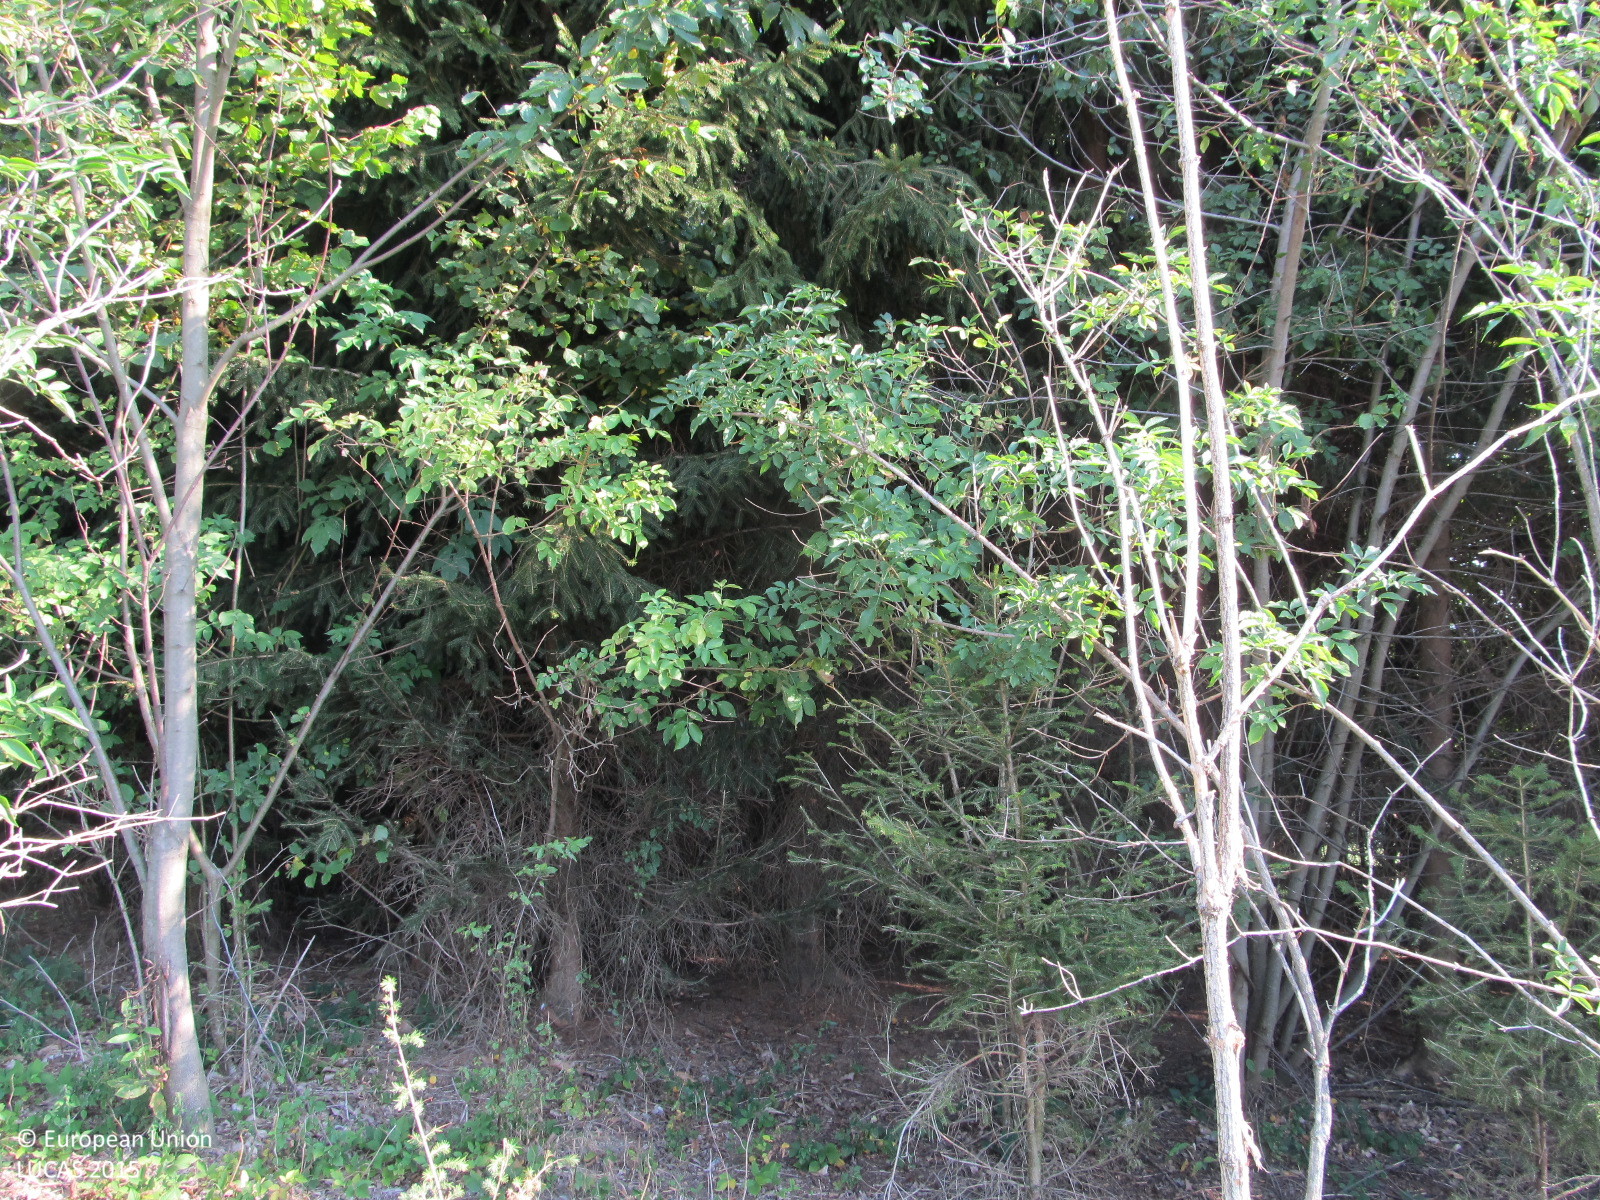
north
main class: Woodland
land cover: Spruce dominated coniferous woodland
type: hemiboreal forest and nemoral coniferous forest and mixed broadleaved-coniferous forest
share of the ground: > 75 %
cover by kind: coniferous forest trees 100 %
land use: Forestry
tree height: > 5 m
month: August
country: AT
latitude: 48.0893
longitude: 15.4394
